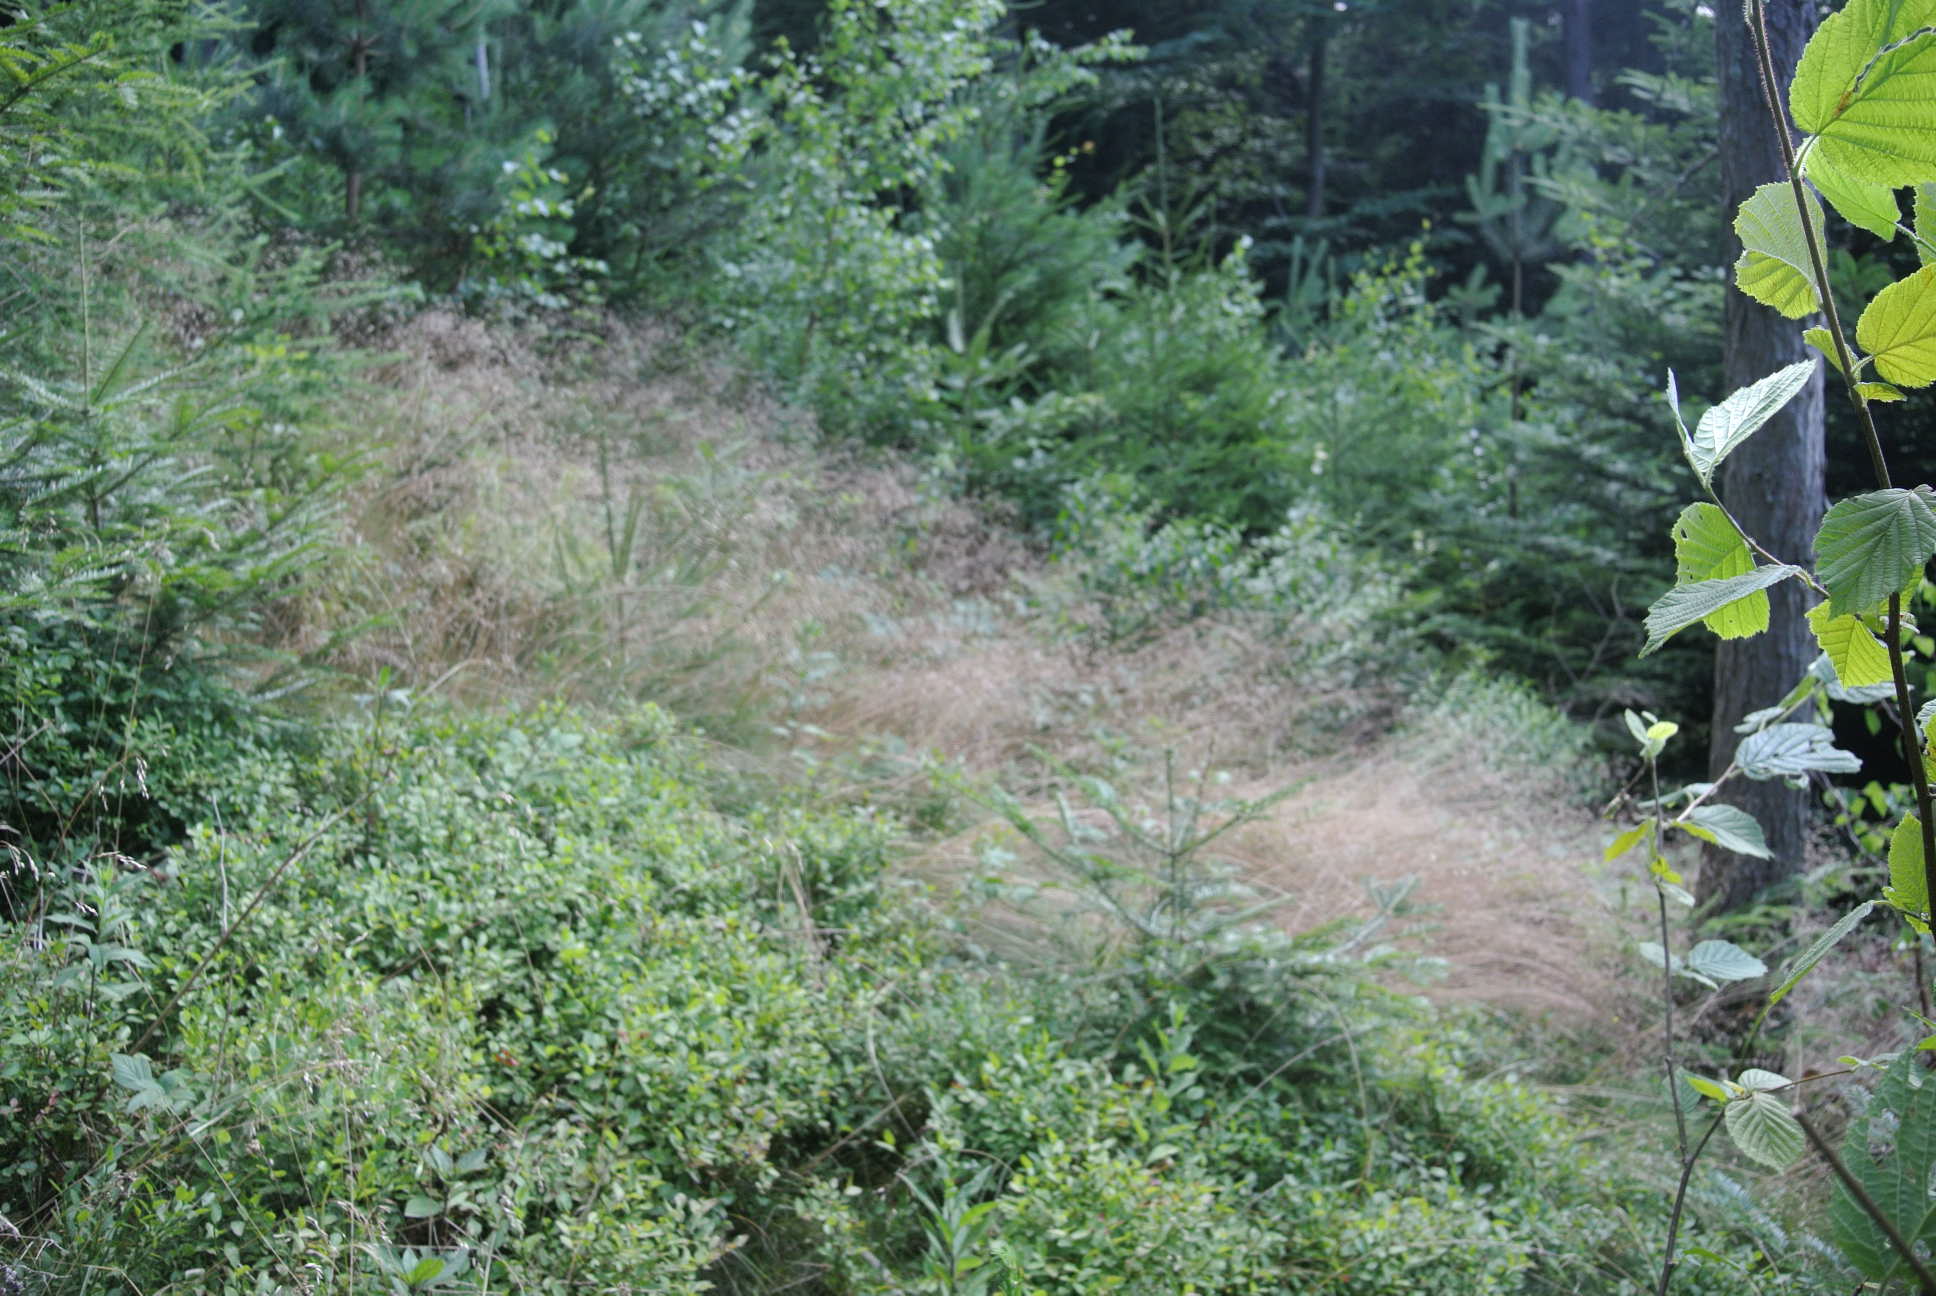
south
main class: Woodland
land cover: Spruce dominated mixed woodland
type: alpine coniferous forest
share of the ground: > 75 %
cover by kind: broadleaved forest trees 60 %, coniferous forest trees 40 %
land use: Forestry
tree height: < 5 m
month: July
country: AT
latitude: 47.5821
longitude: 16.1589
